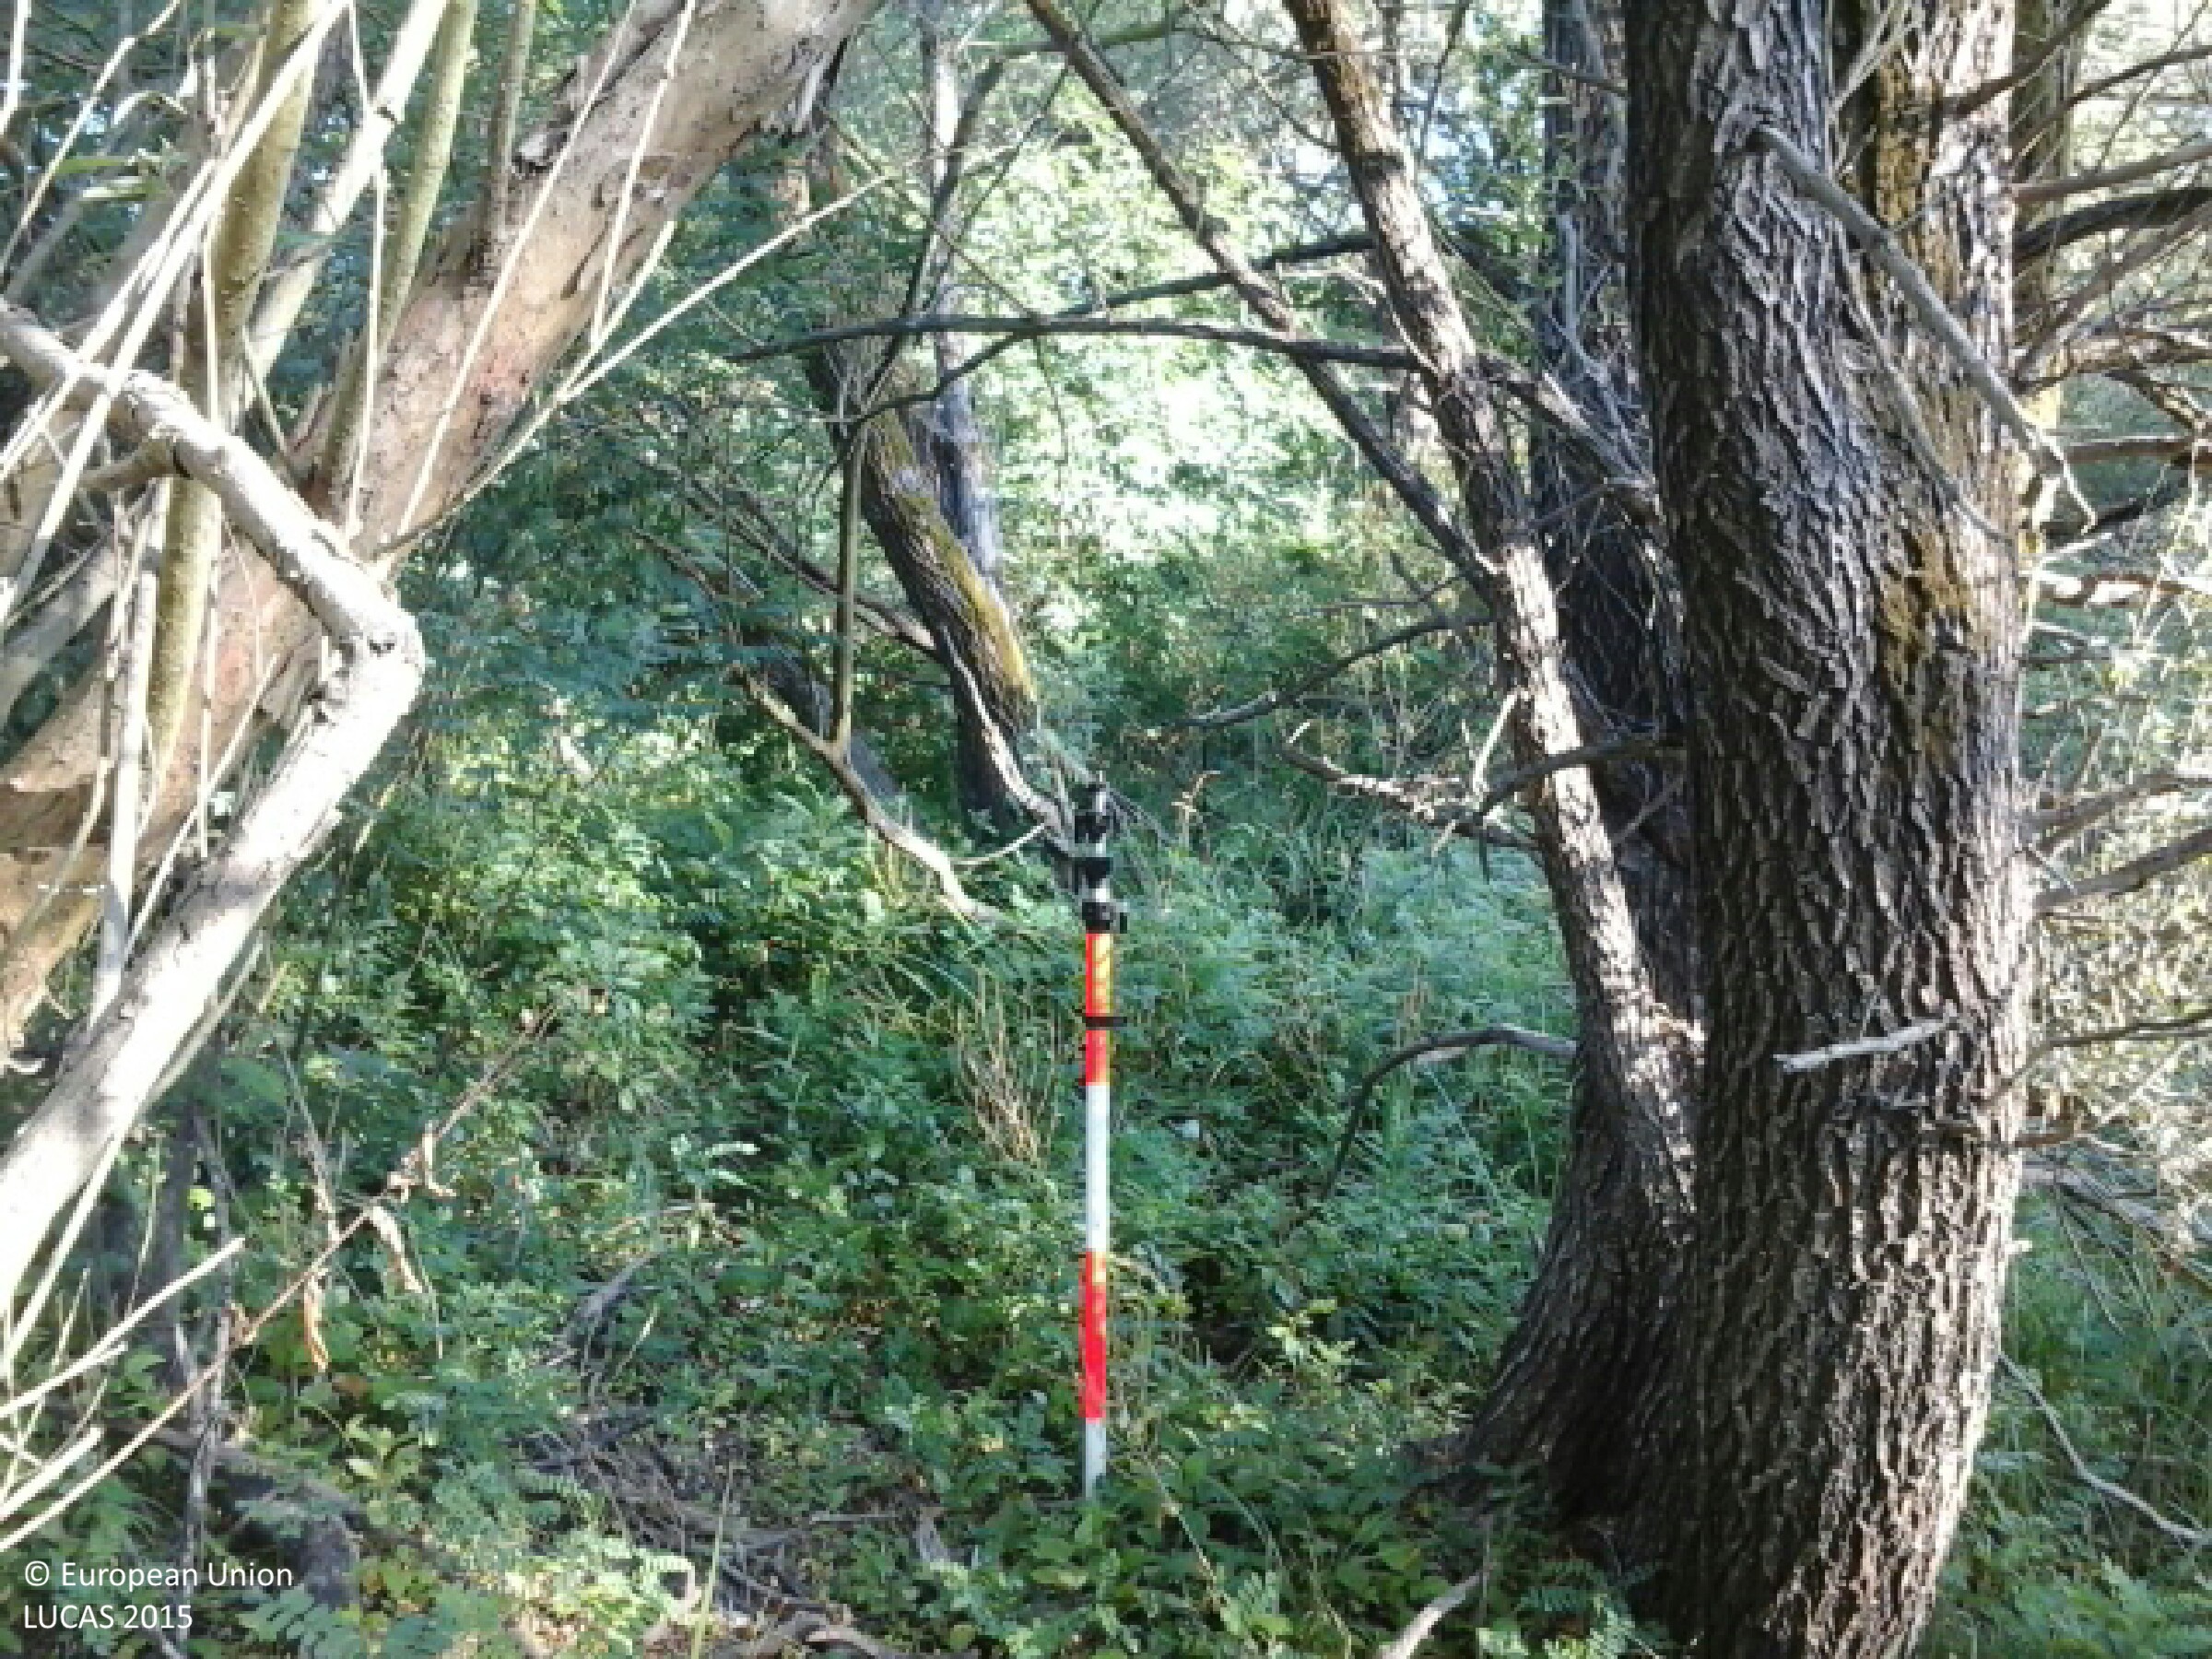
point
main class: Woodland
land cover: Broadleaved woodland
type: mesophytic deciduous forest
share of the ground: > 75 %
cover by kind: broadleaved forest trees 95 %, herbaceous plants 5 %
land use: Forestry
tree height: > 5 m
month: July
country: HU
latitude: 48.3527
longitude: 21.6130
